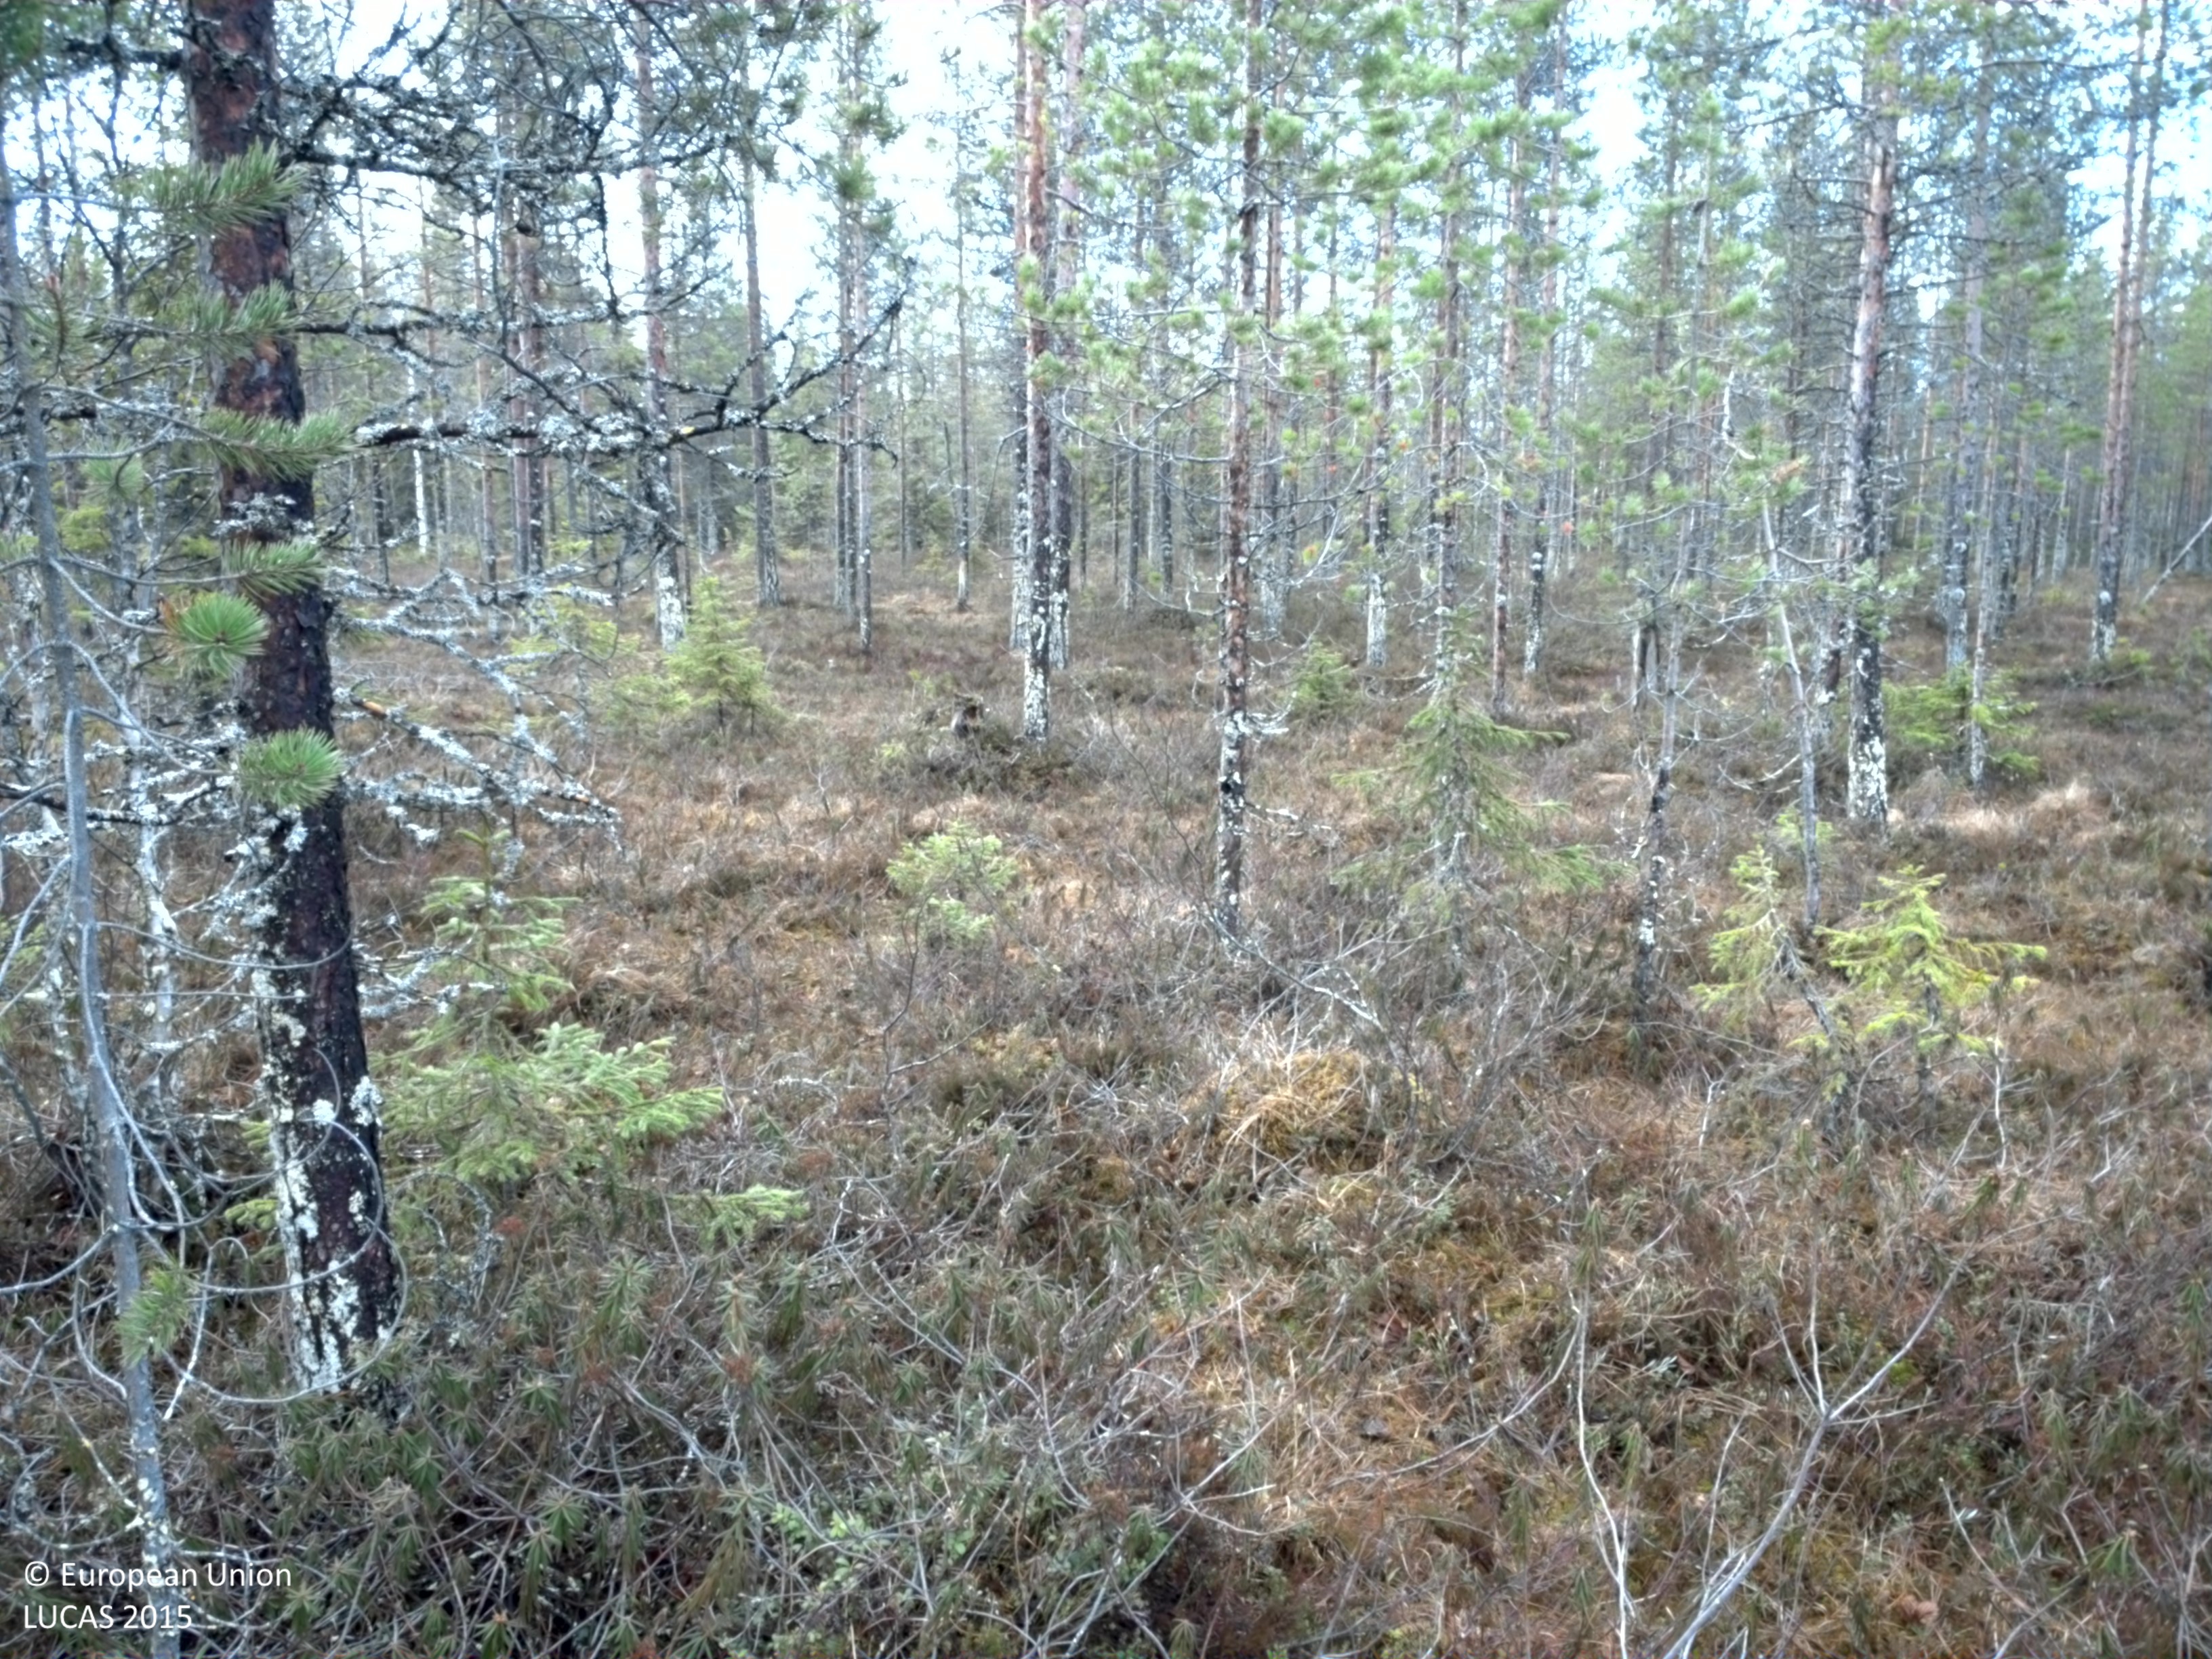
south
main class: Woodland
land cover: Pine dominated coniferous woodland
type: boreal forest
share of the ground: > 75 %
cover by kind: coniferous forest trees 80 %, shrubs 20 %
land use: Forestry
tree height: > 5 m
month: May
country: SE
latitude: 66.1979
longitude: 23.4214
